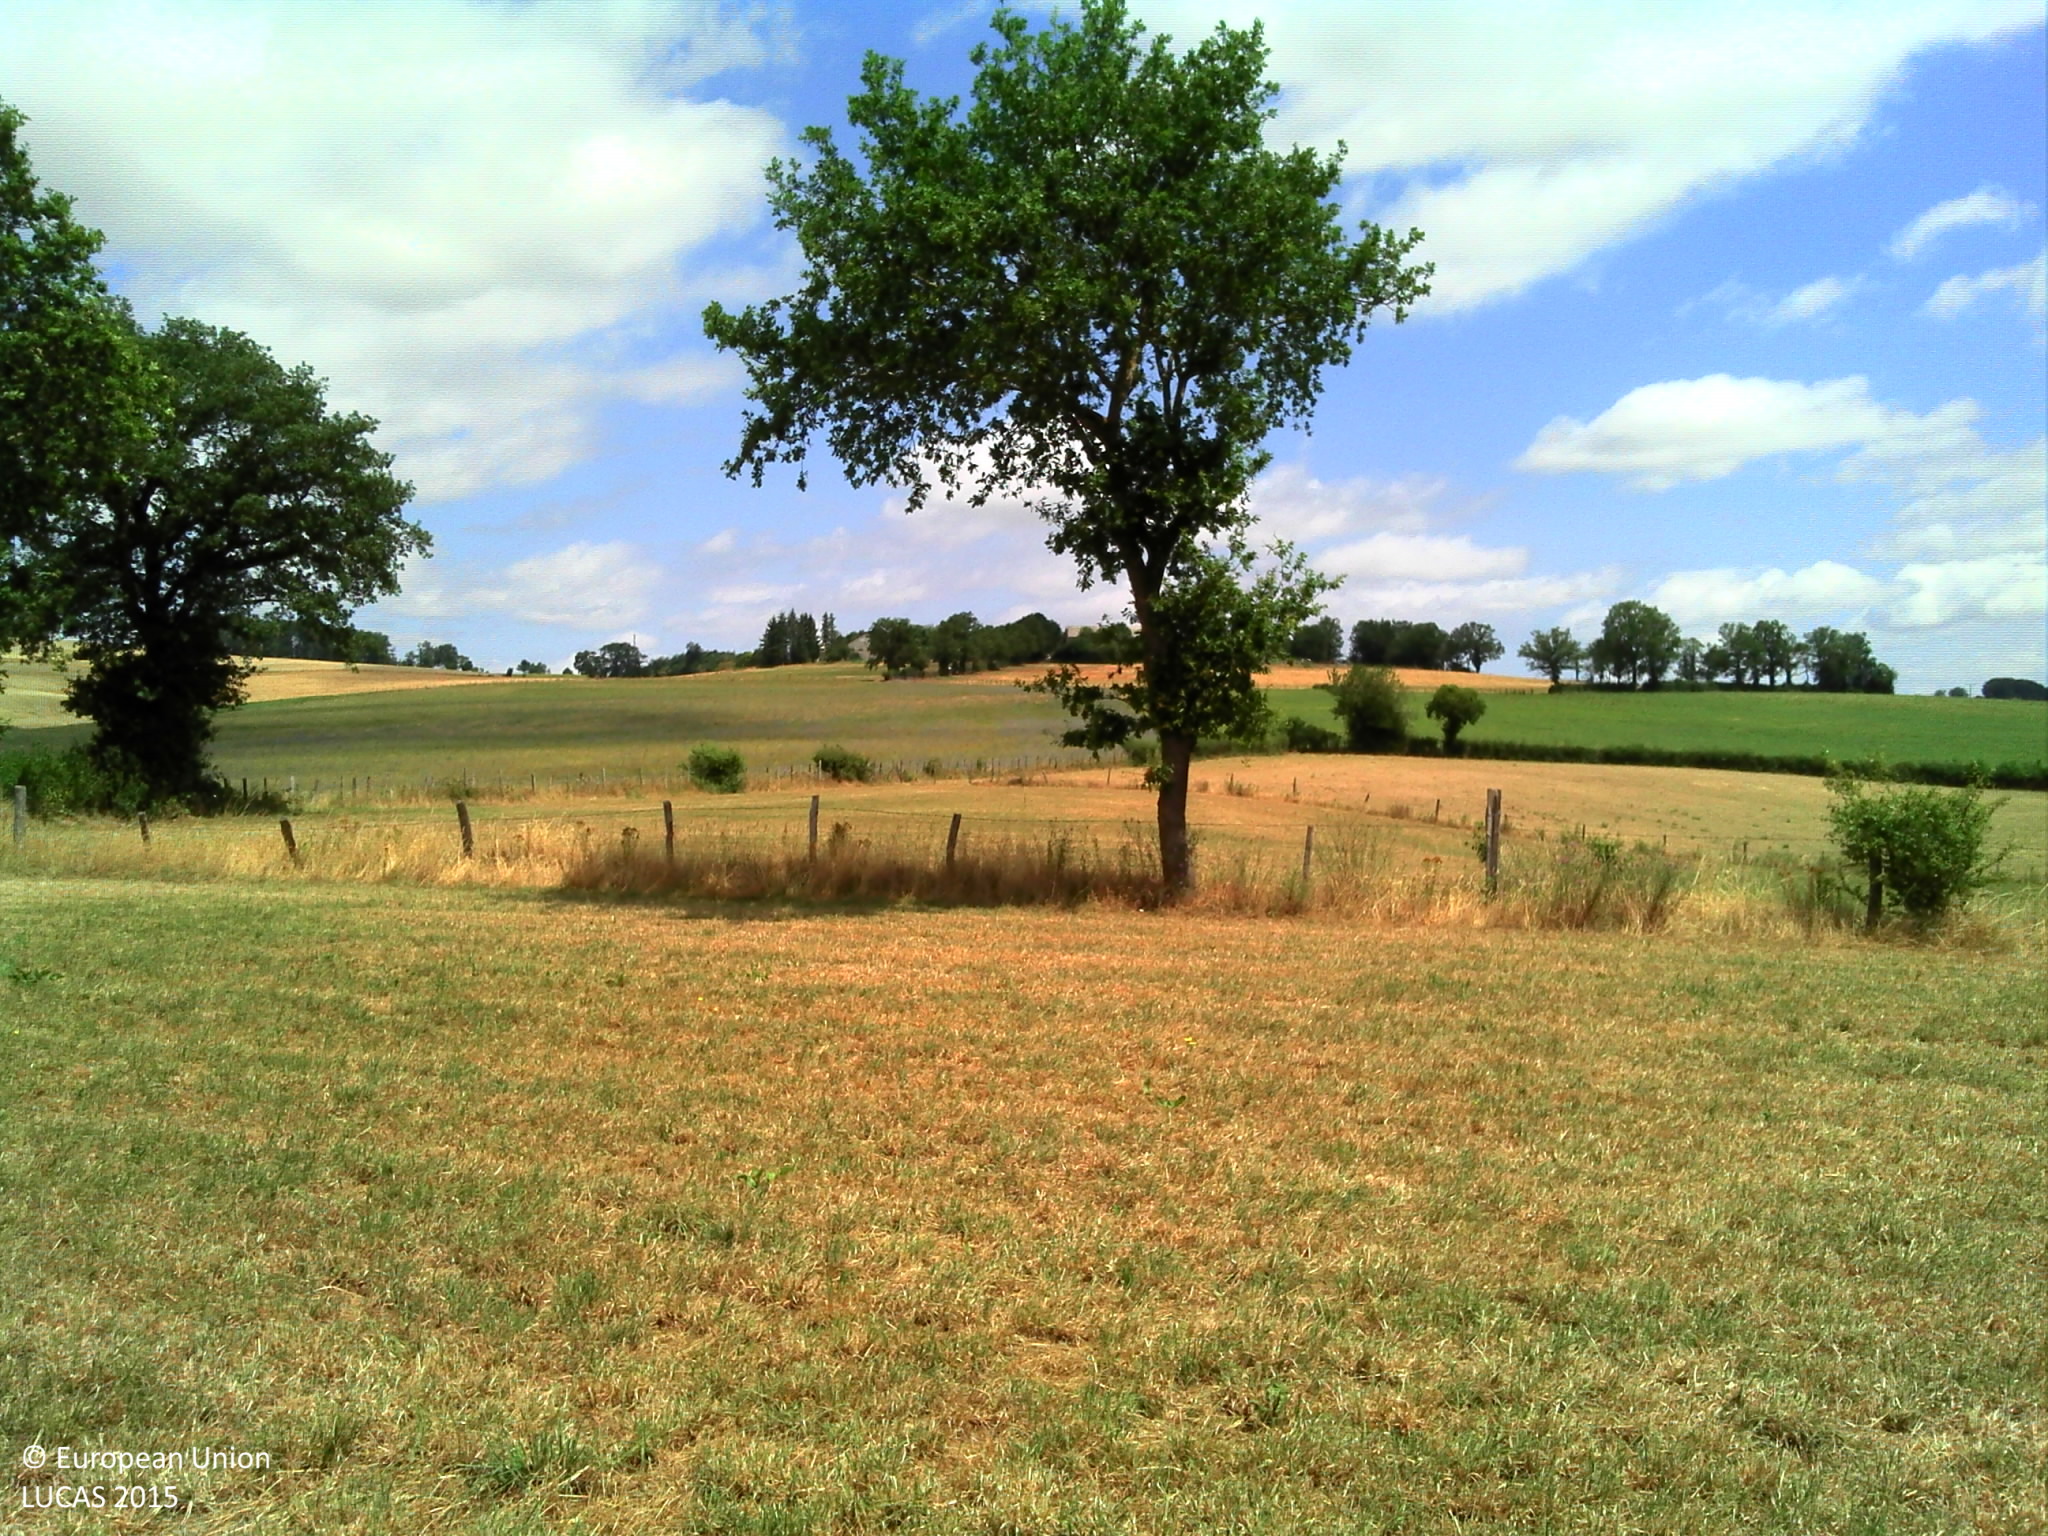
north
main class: Cropland
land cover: Temporary grasslands
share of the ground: > 75 %
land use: Agriculture (excluding fallow land and kitchen gardens)
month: July
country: FR
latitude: 44.1165
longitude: 2.5195
